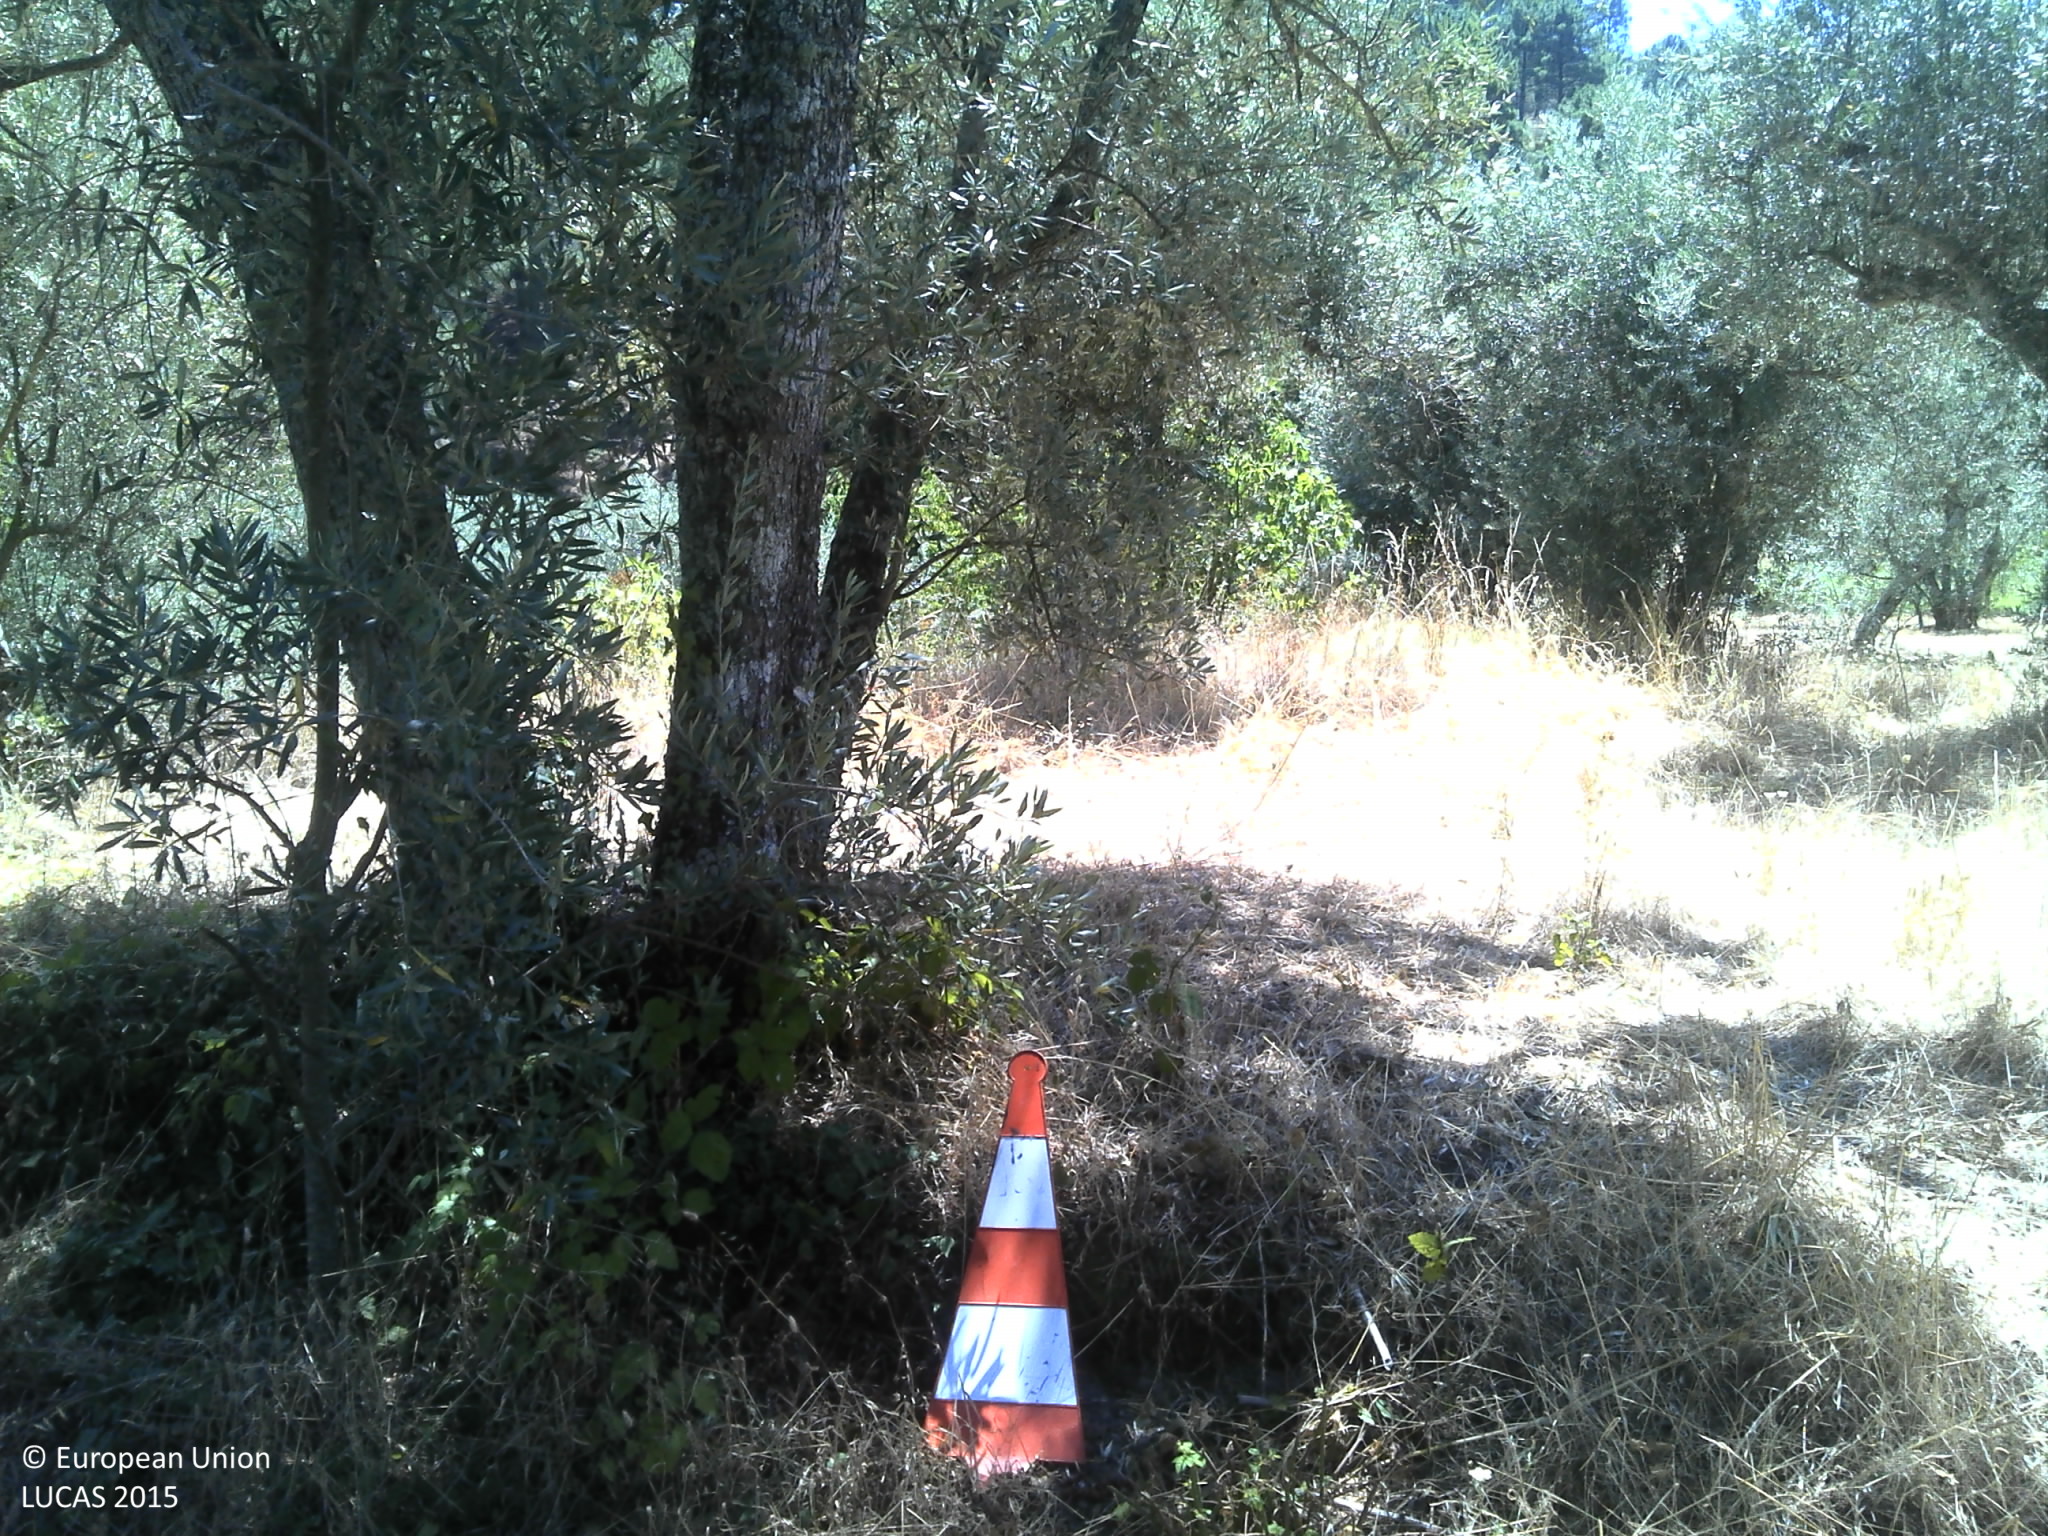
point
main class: Cropland
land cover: Olive groves
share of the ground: 50 - 75 %
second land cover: Grassland without tree/shrub cover
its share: 50 - 75 %
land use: Agriculture (excluding fallow land and kitchen gardens)
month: August
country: PT
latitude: 40.5770
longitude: -7.3197
